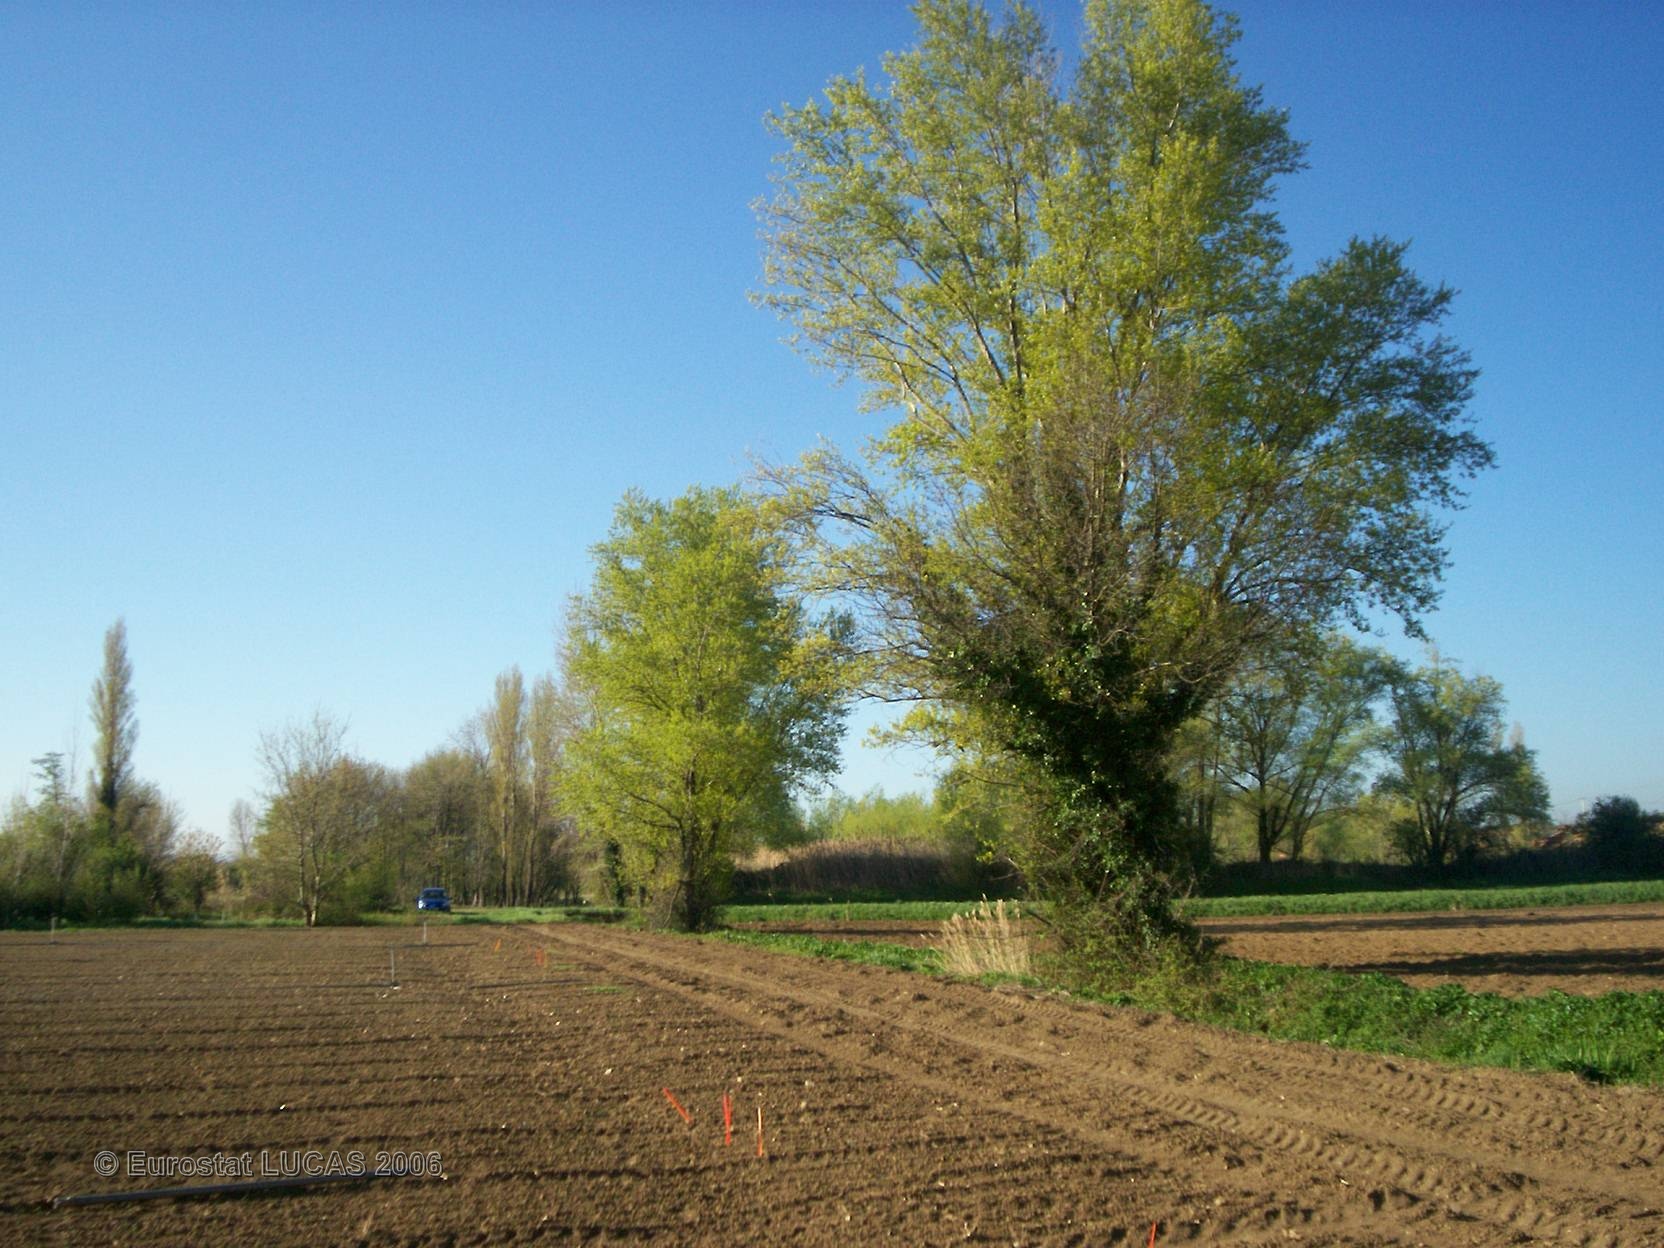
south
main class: Cropland
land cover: Other fresh vegetables
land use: Agriculture (excluding fallow land and kitchen gardens)
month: April
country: FR
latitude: 44.8038
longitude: 4.9110
